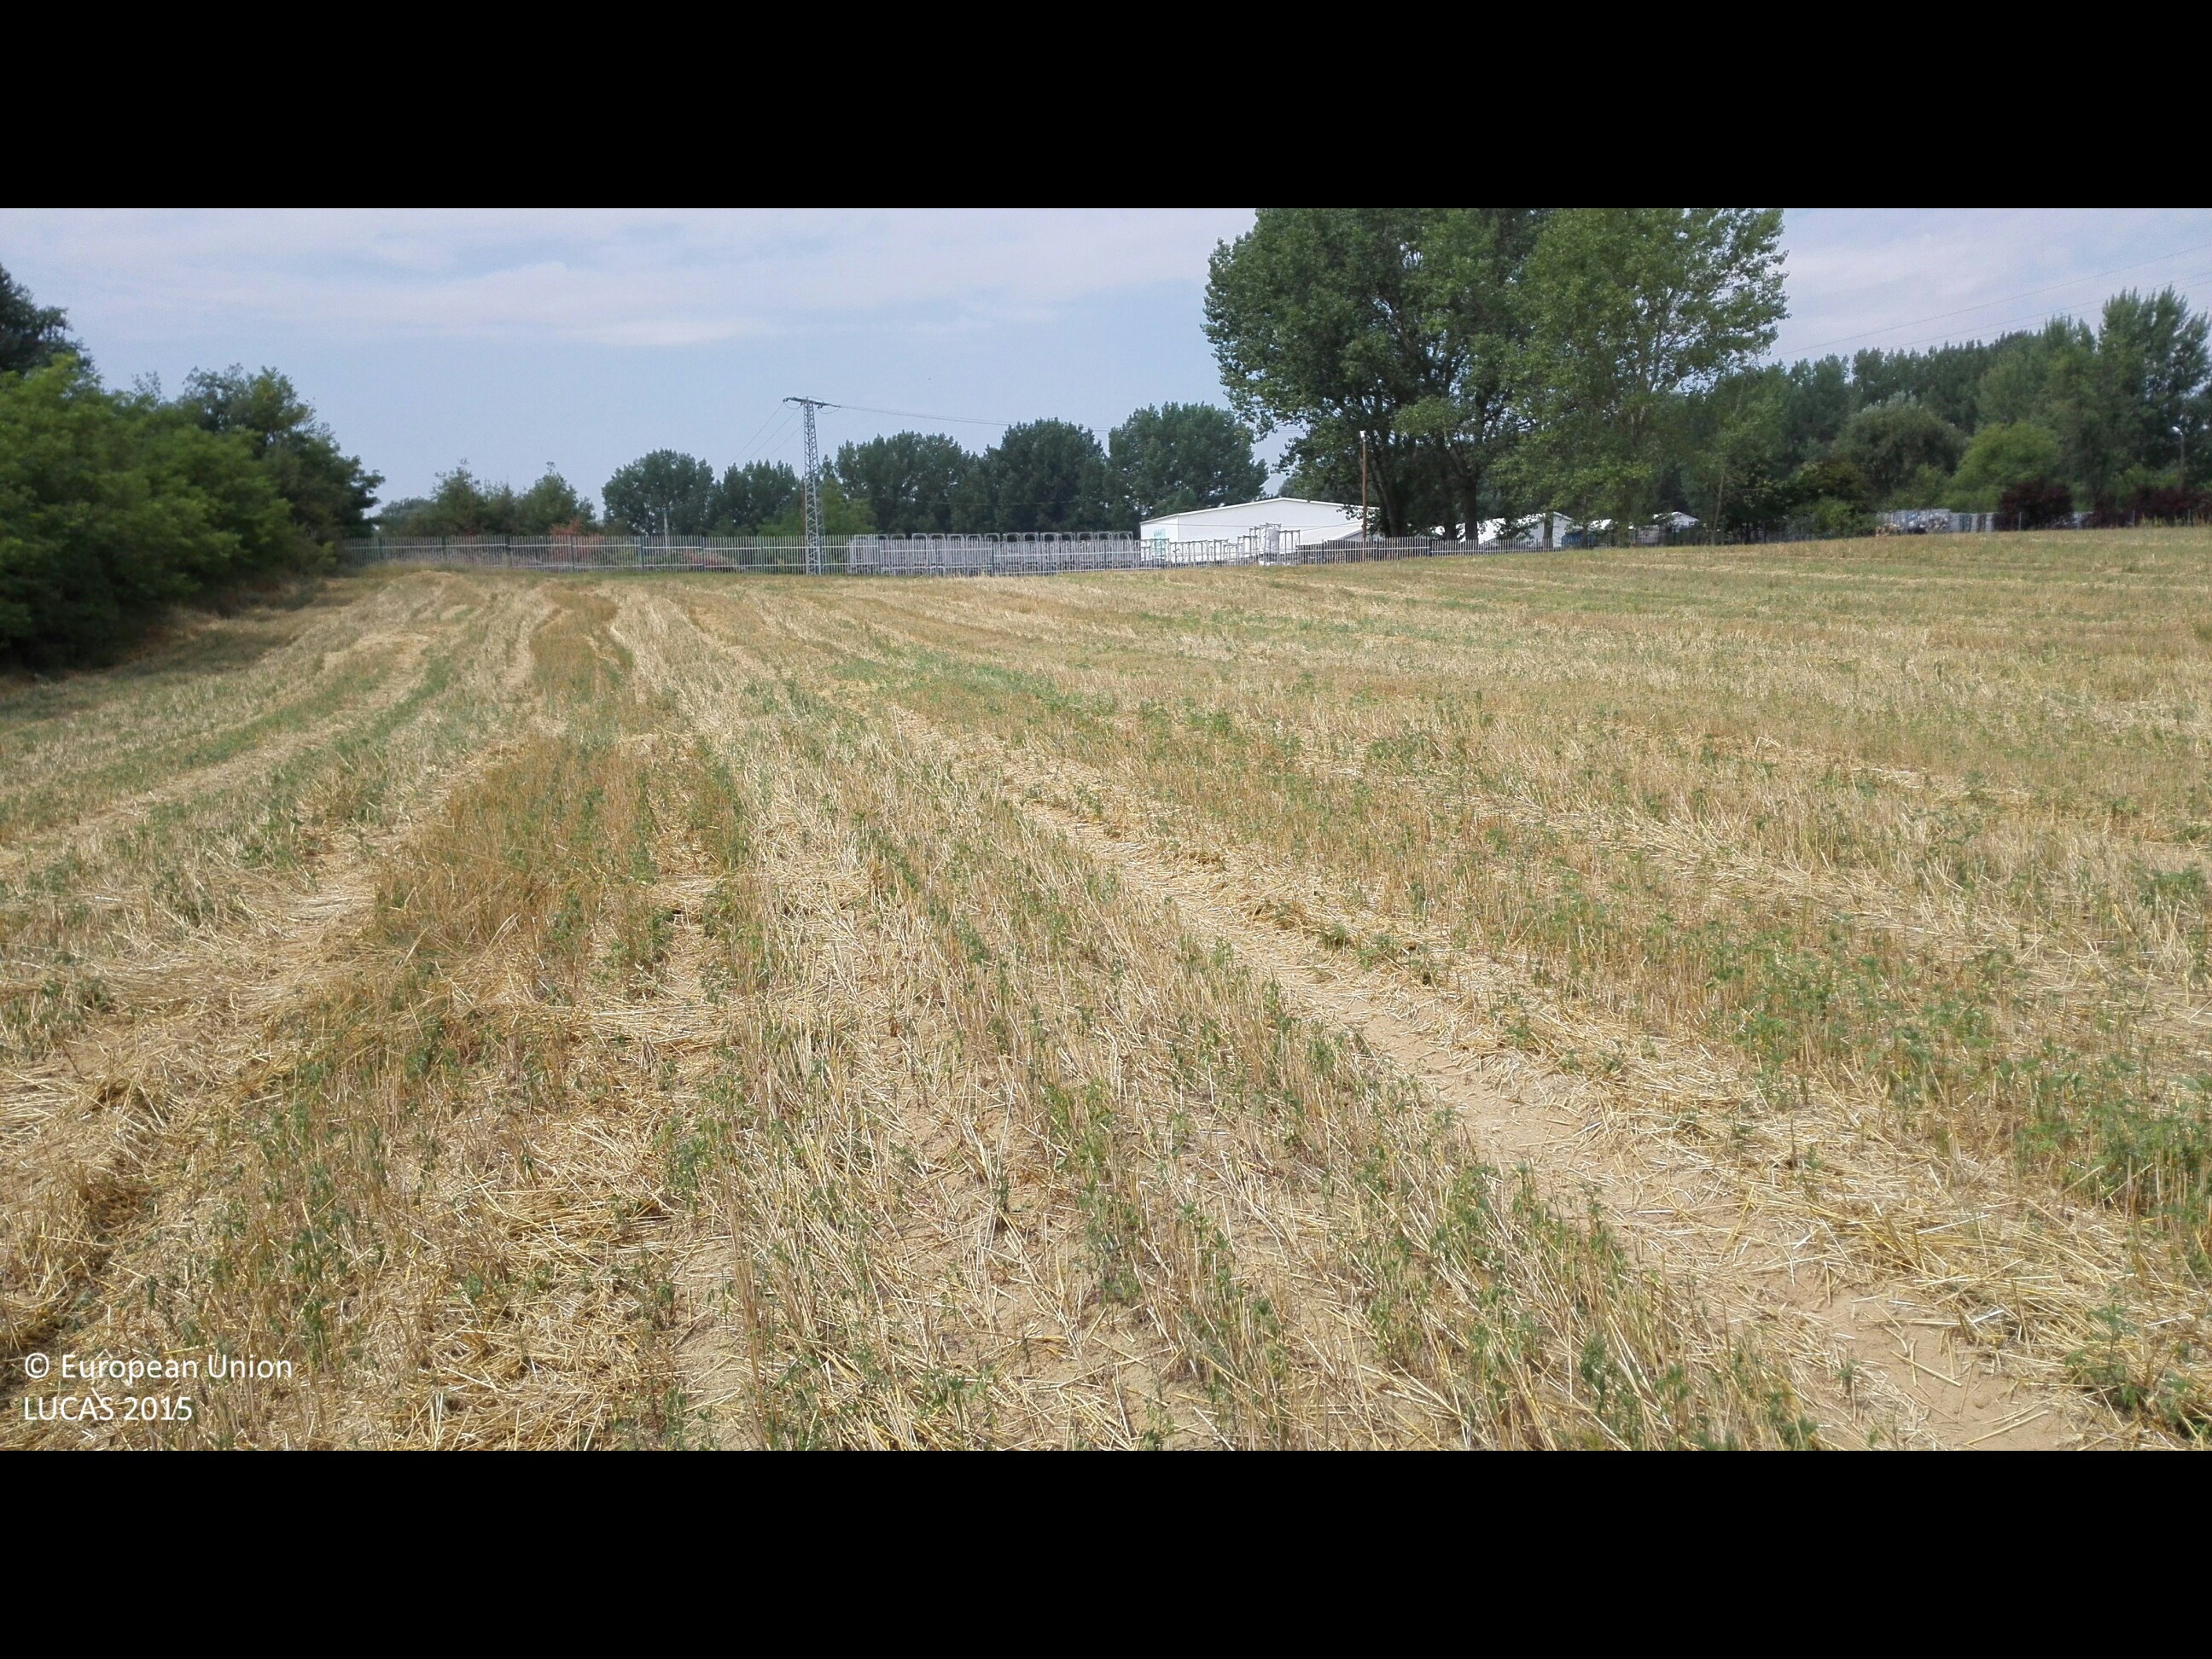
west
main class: Cropland
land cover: Rye
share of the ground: > 75 %
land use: Agriculture (excluding fallow land and kitchen gardens)
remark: Harvested field
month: August
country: HU
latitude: 47.5296
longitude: 21.8291
